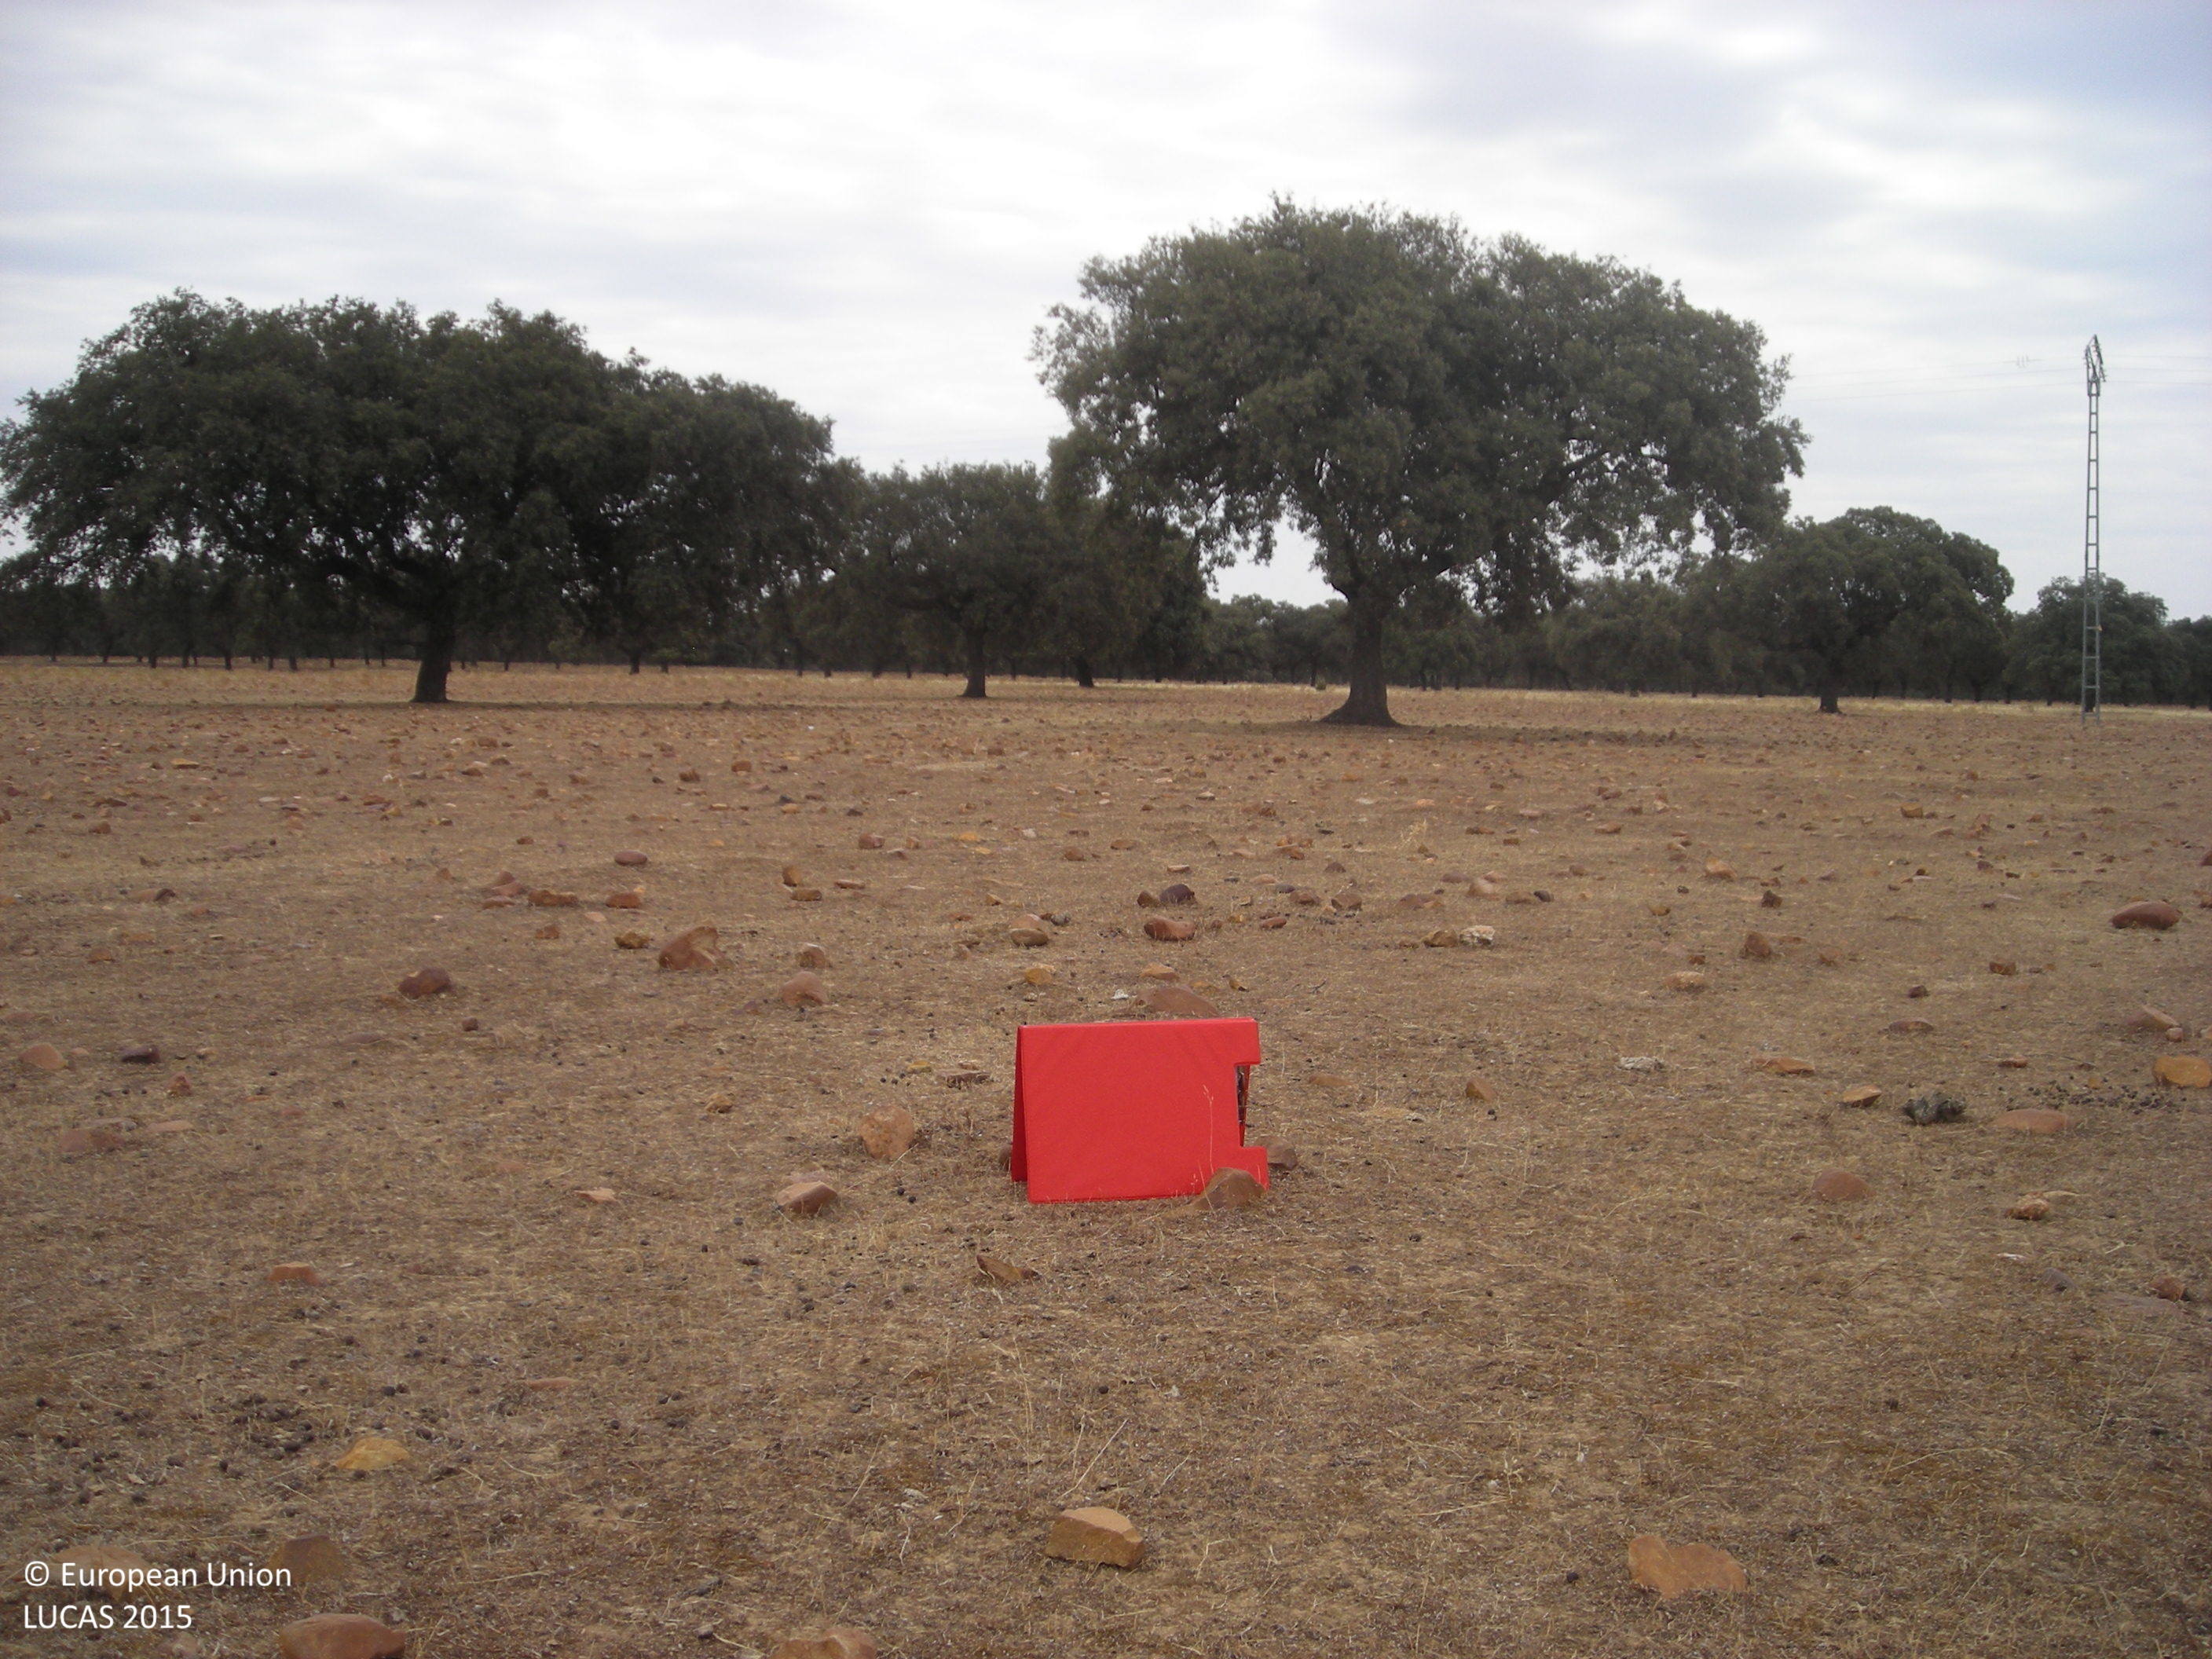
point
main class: Grassland
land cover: Grassland without tree/shrub cover
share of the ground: > 75 %
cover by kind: herbaceous plants 100 %
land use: Agriculture (excluding fallow land and kitchen gardens)
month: July
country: ES
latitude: 39.1743
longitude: -5.4994
